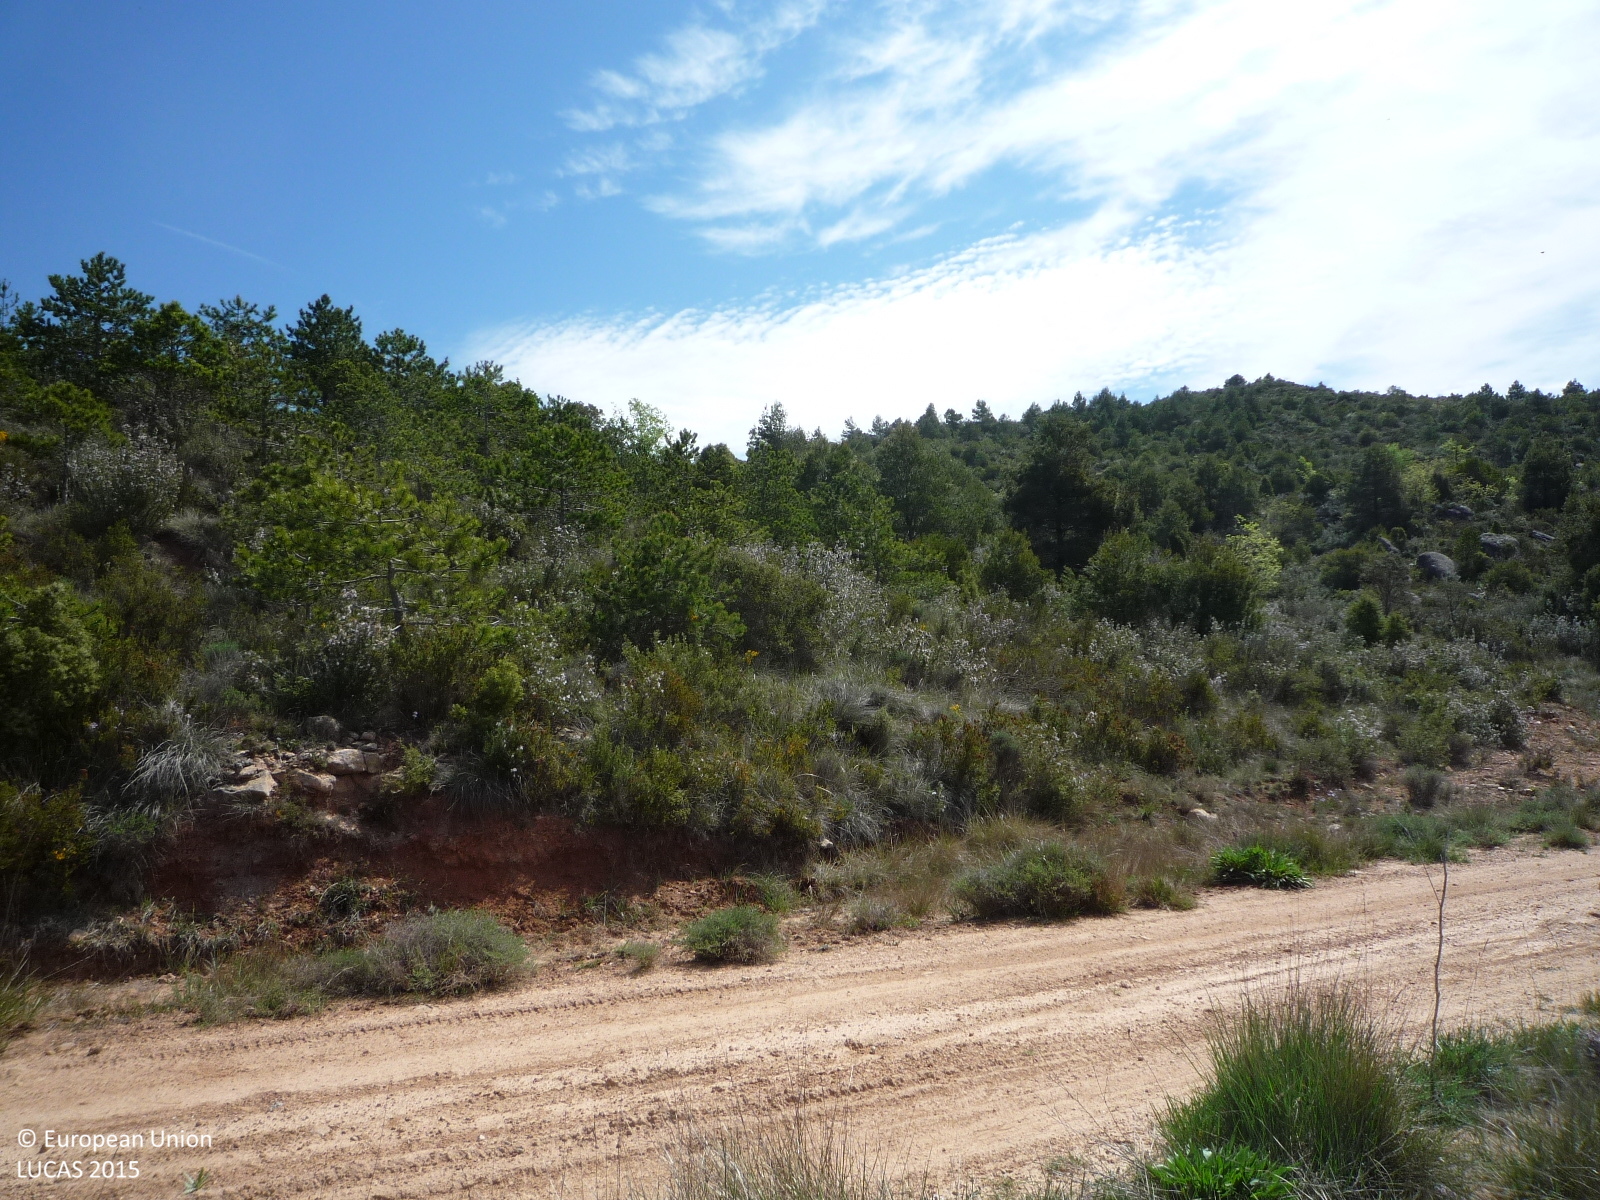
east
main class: Shrubland
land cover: Shrubland with sparse tree cover
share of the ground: > 75 %
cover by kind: shrubs 60 %, herbaceous plants 35 %, broadleaved forest trees 5 %
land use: Semi-natural and natural areas not in use
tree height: < 5 m
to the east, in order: Shrubland with sparse tree cover; Tracks; Shrubland with sparse tree cover; Tracks; Shrubland with sparse tree cover; Rock outcrops; Shrubland with sparse tree cover; Pine dominated coniferous woodland; Rock outcrops; Shrubland with sparse tree cover; Tracks
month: April
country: ES
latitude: 41.7107
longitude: 1.6620
